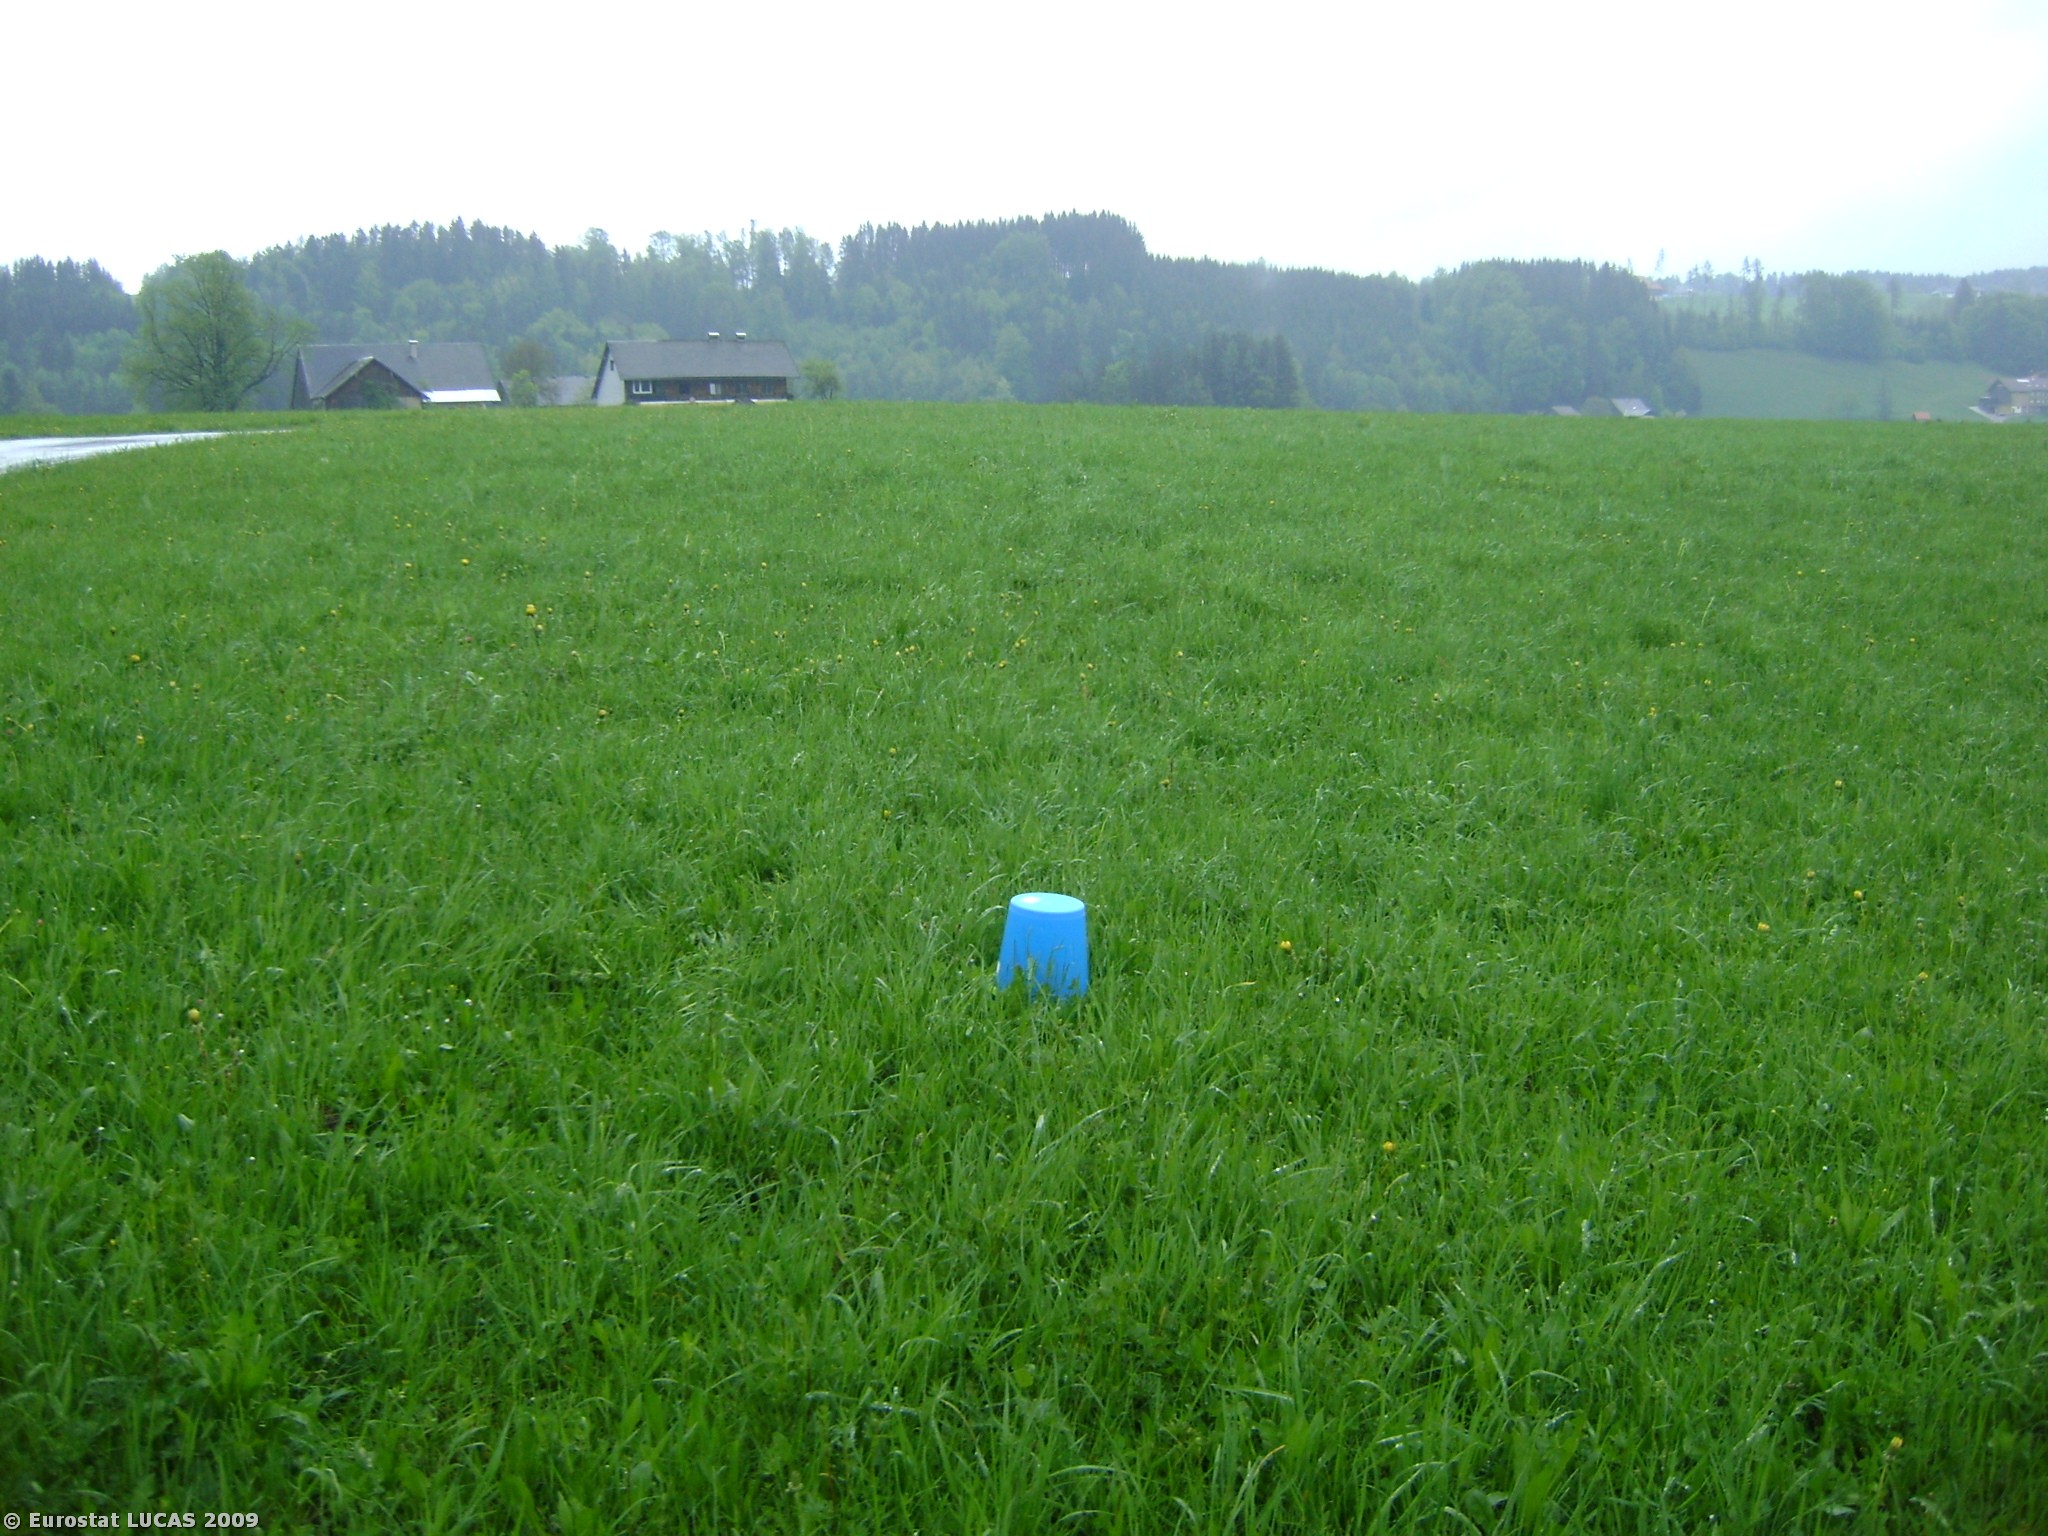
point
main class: Grassland
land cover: Grassland without tree/shrub cover
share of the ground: > 75 %
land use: Agriculture (excluding fallow land and kitchen gardens)
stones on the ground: < 10 %
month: May
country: AT
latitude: 47.8156
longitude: 13.2440
